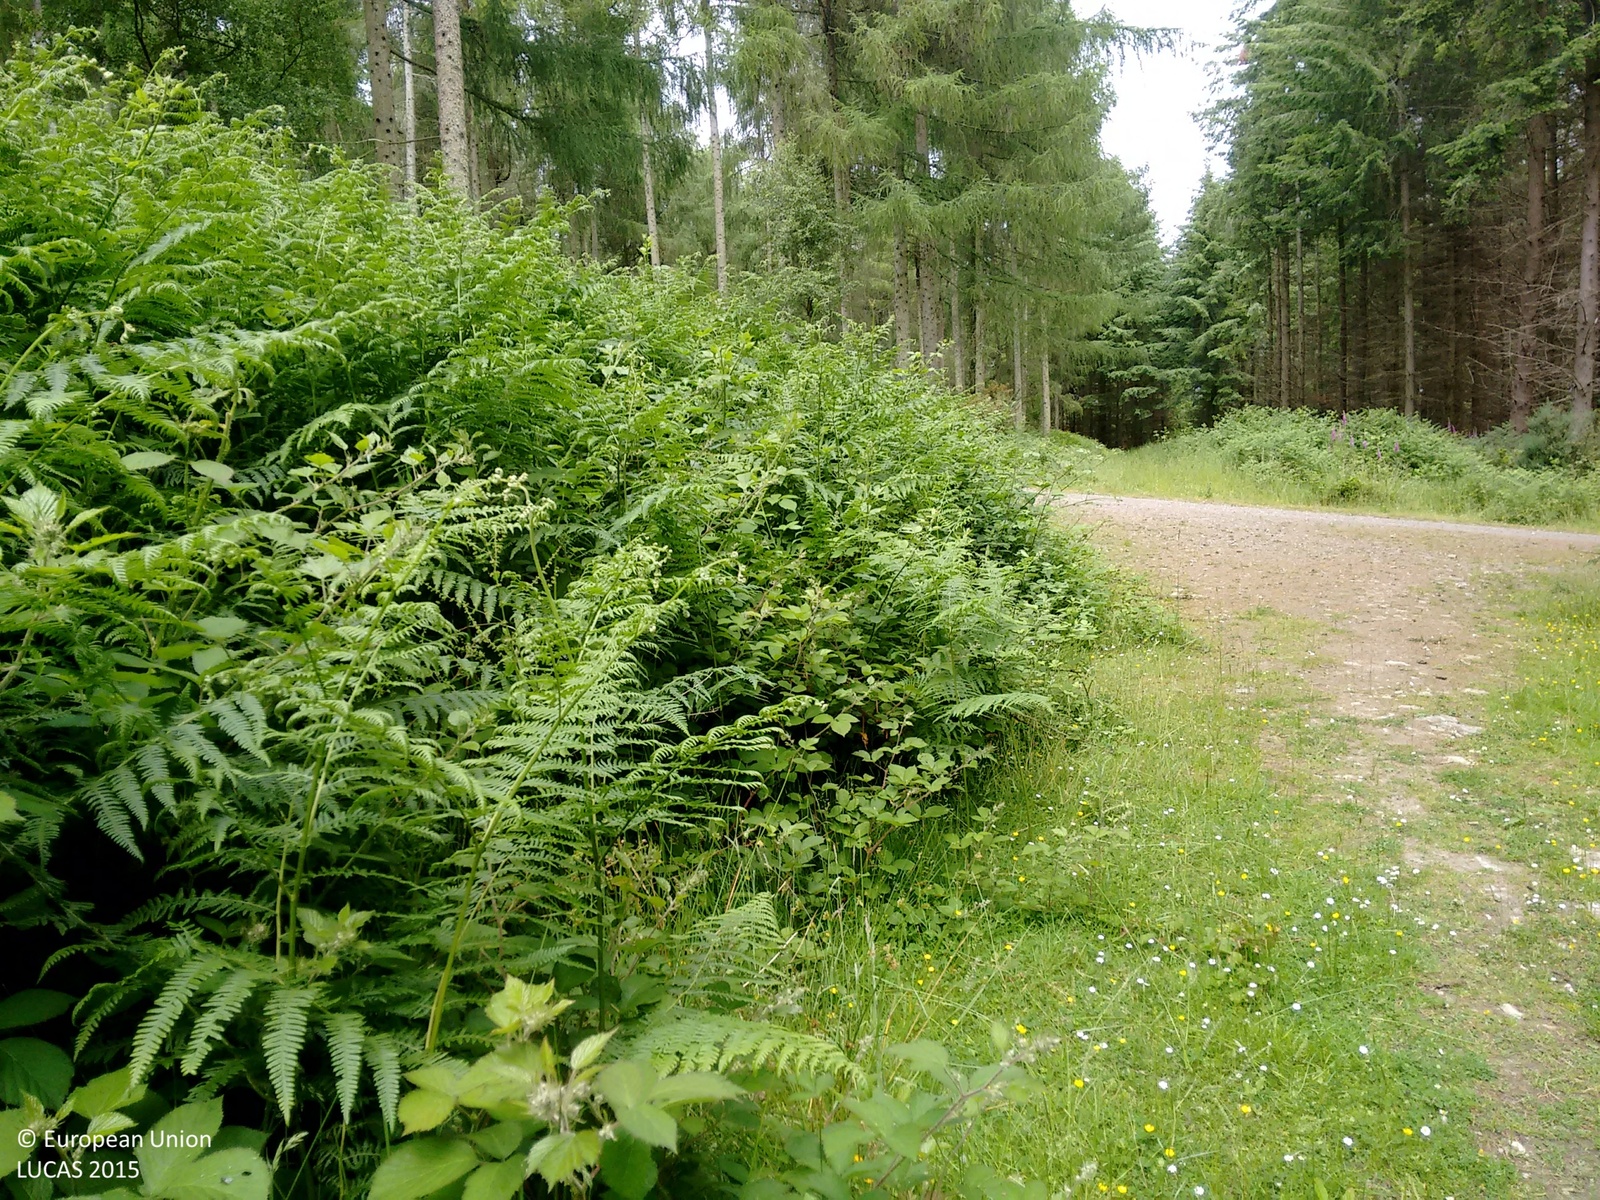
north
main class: Woodland
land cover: Spruce dominated coniferous woodland
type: exotic forest
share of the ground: > 75 %
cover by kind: coniferous forest trees 95 %, shrubs 5 %
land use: Forestry
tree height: > 5 m
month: June
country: GB
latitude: 52.3017
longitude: -2.7856
